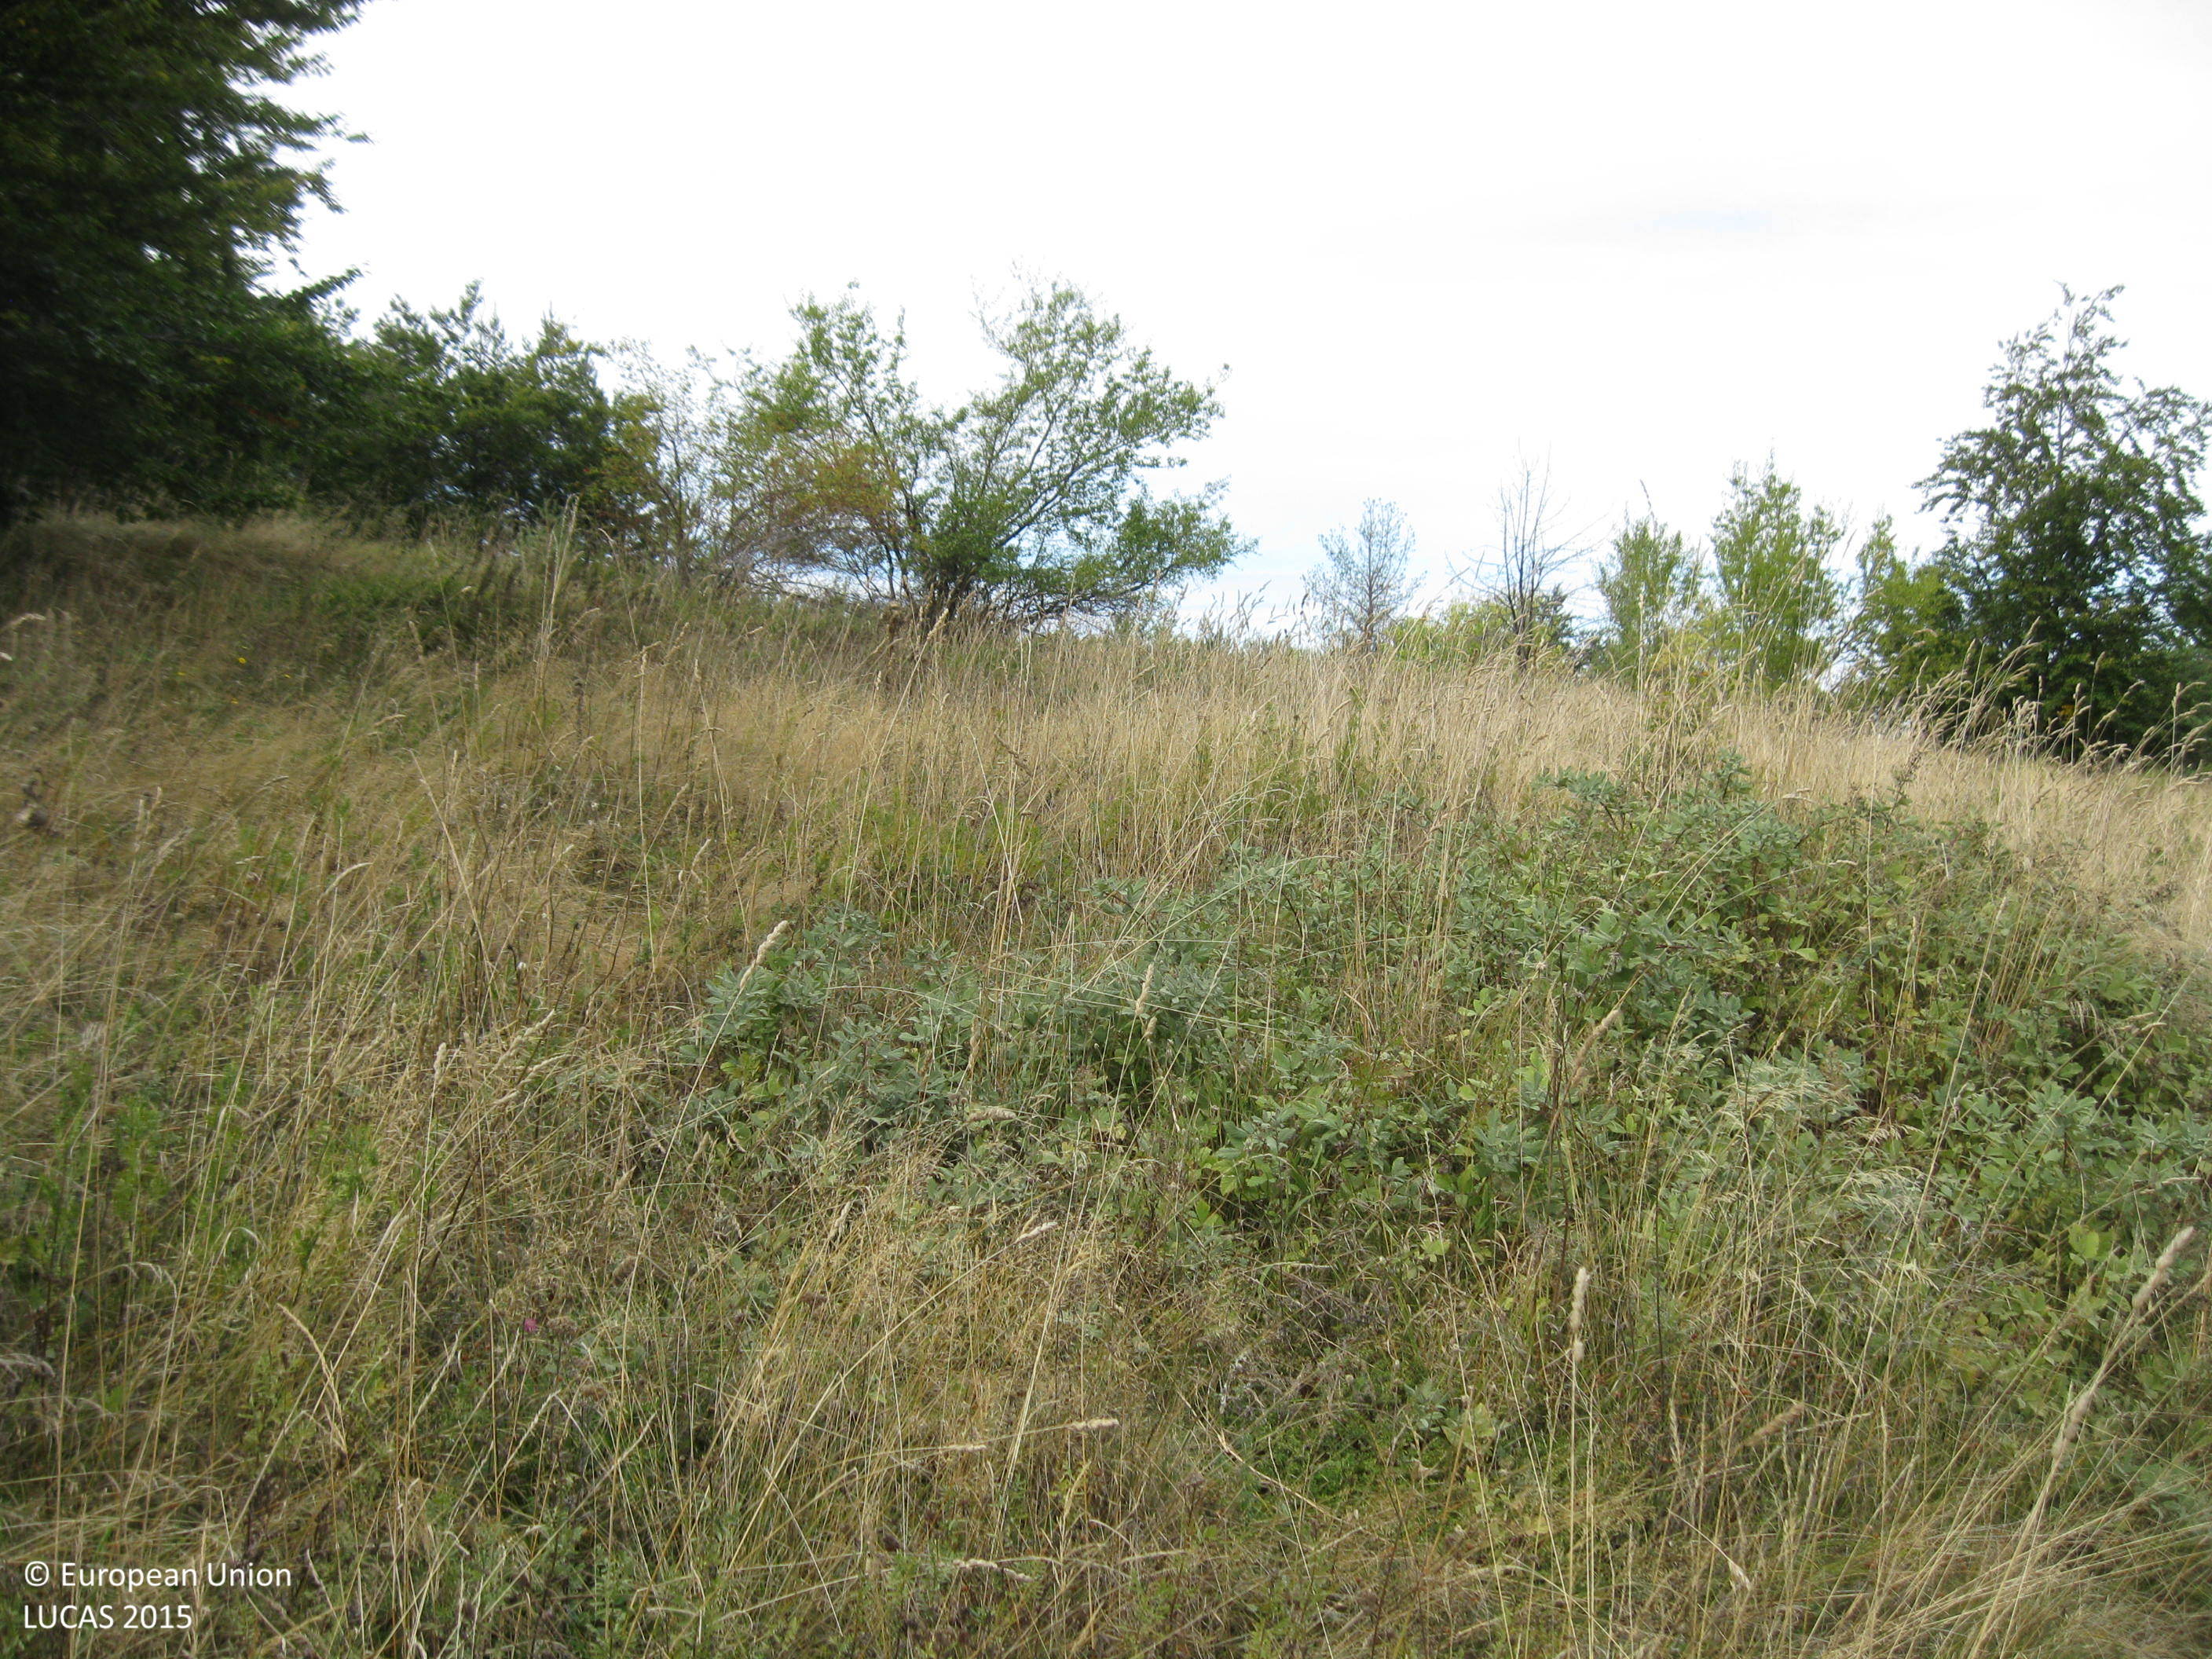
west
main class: Grassland
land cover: Grassland without tree/shrub cover
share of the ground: > 75 %
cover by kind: herbaceous plants 100 %
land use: Agriculture (excluding fallow land and kitchen gardens)
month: October
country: BG
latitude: 42.0007
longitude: 24.5457
